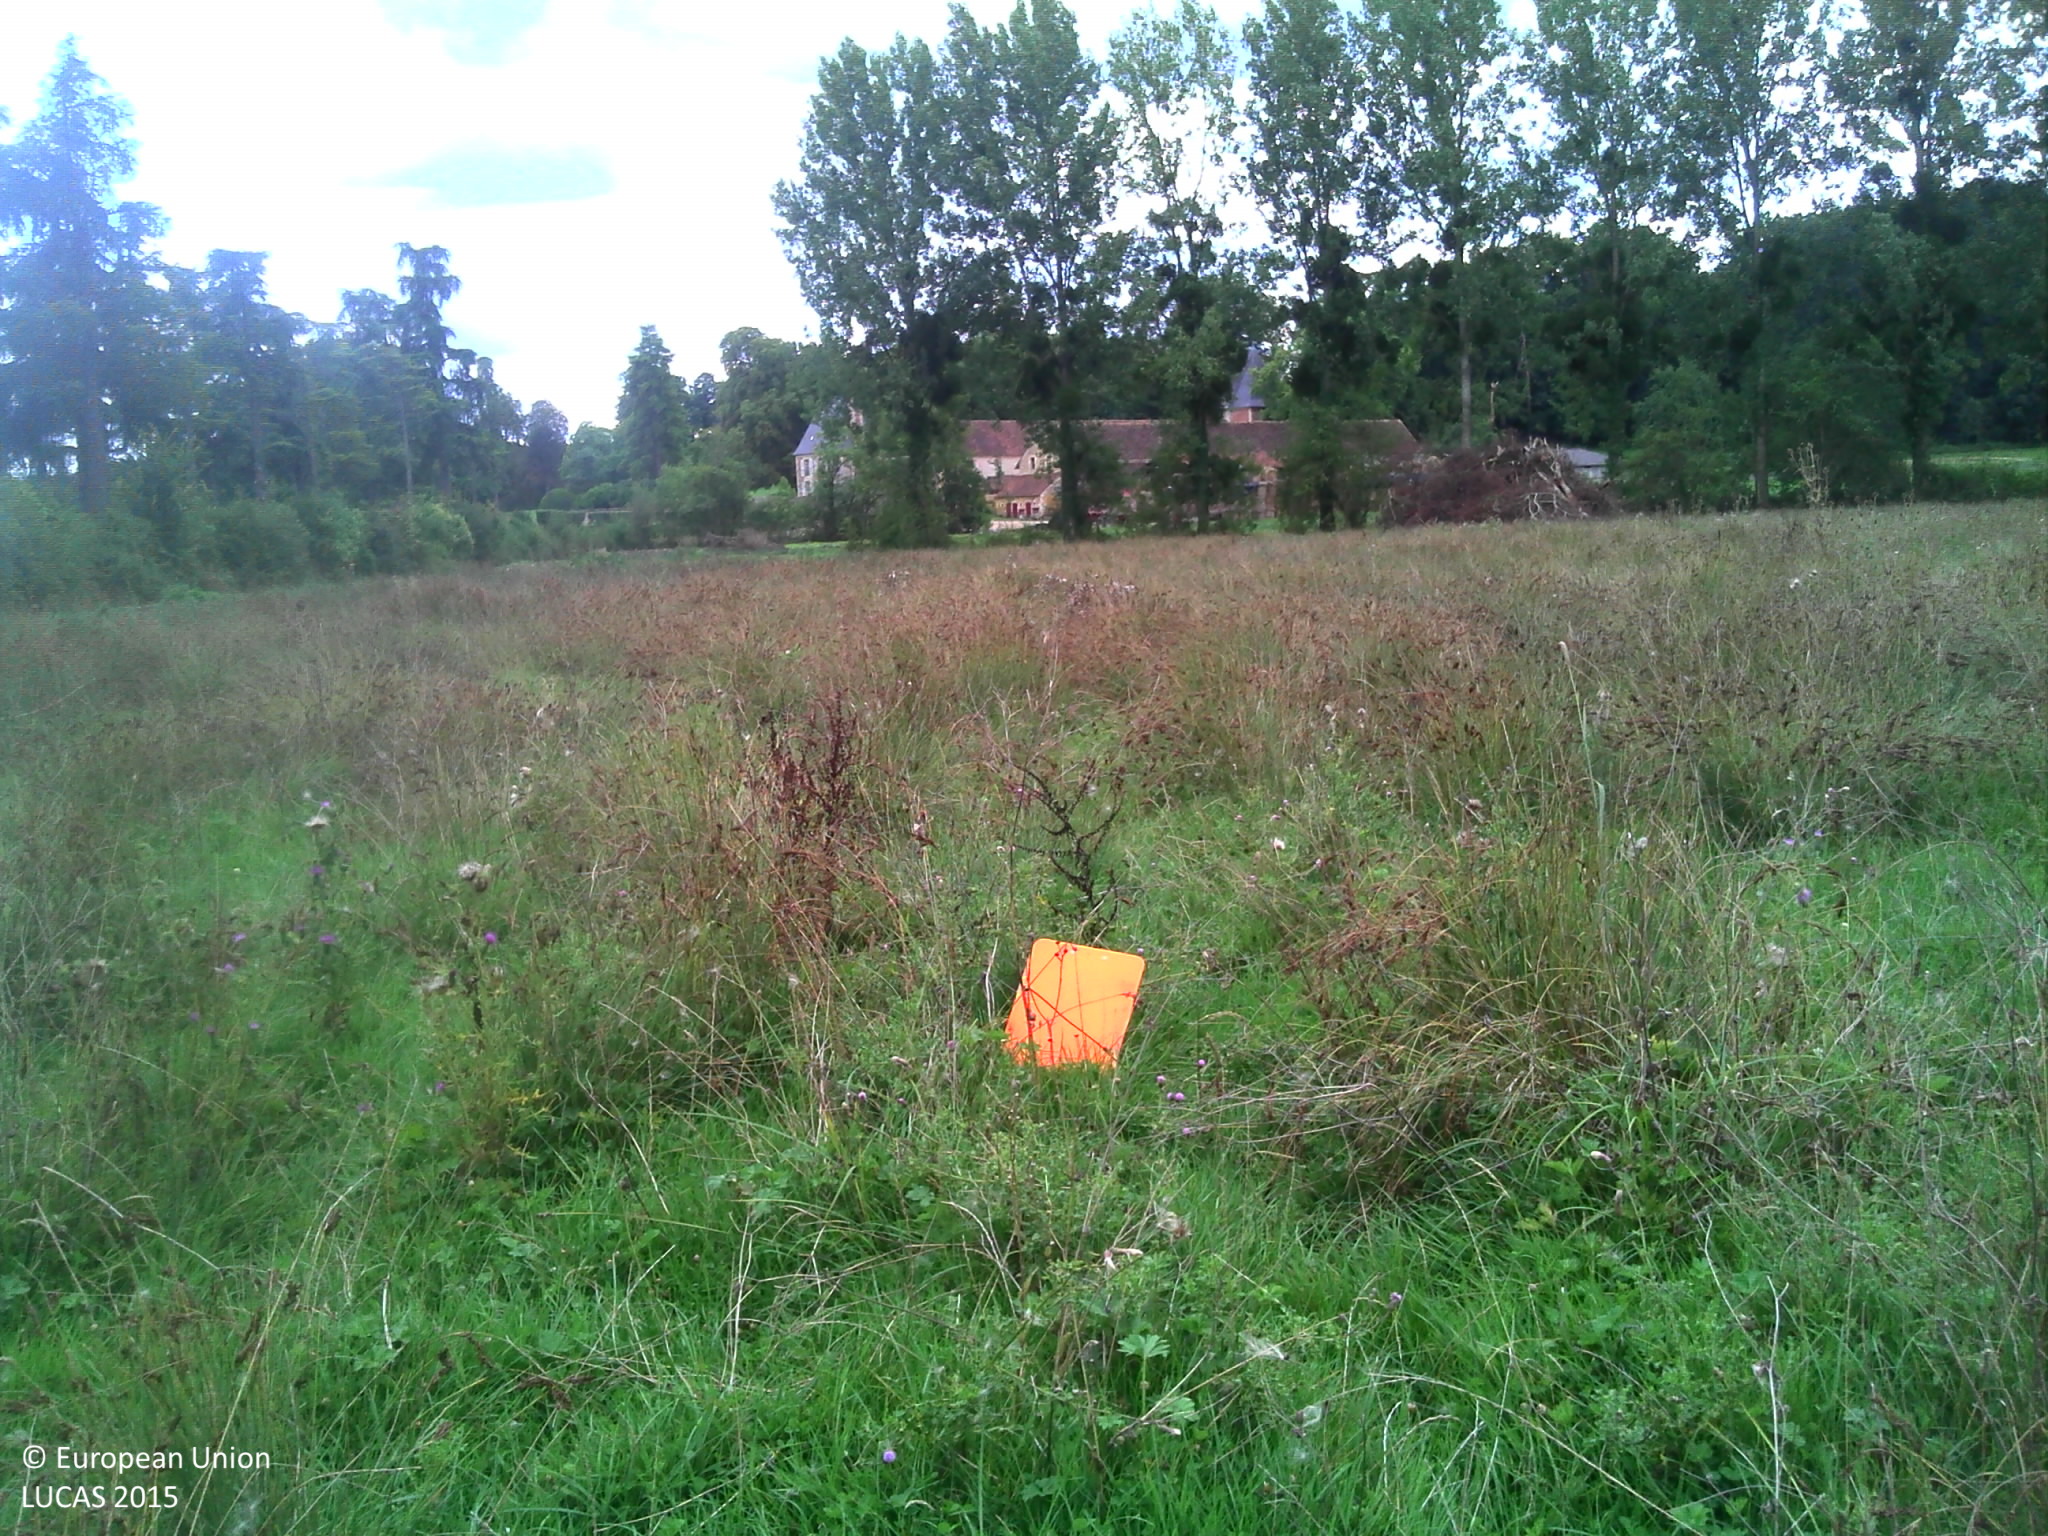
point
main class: Grassland
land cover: Grassland without tree/shrub cover
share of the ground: > 75 %
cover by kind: herbaceous plants 95 %, shrubs 5 %
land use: Agriculture (excluding fallow land and kitchen gardens)
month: September
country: FR
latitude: 48.3038
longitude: 0.5252
